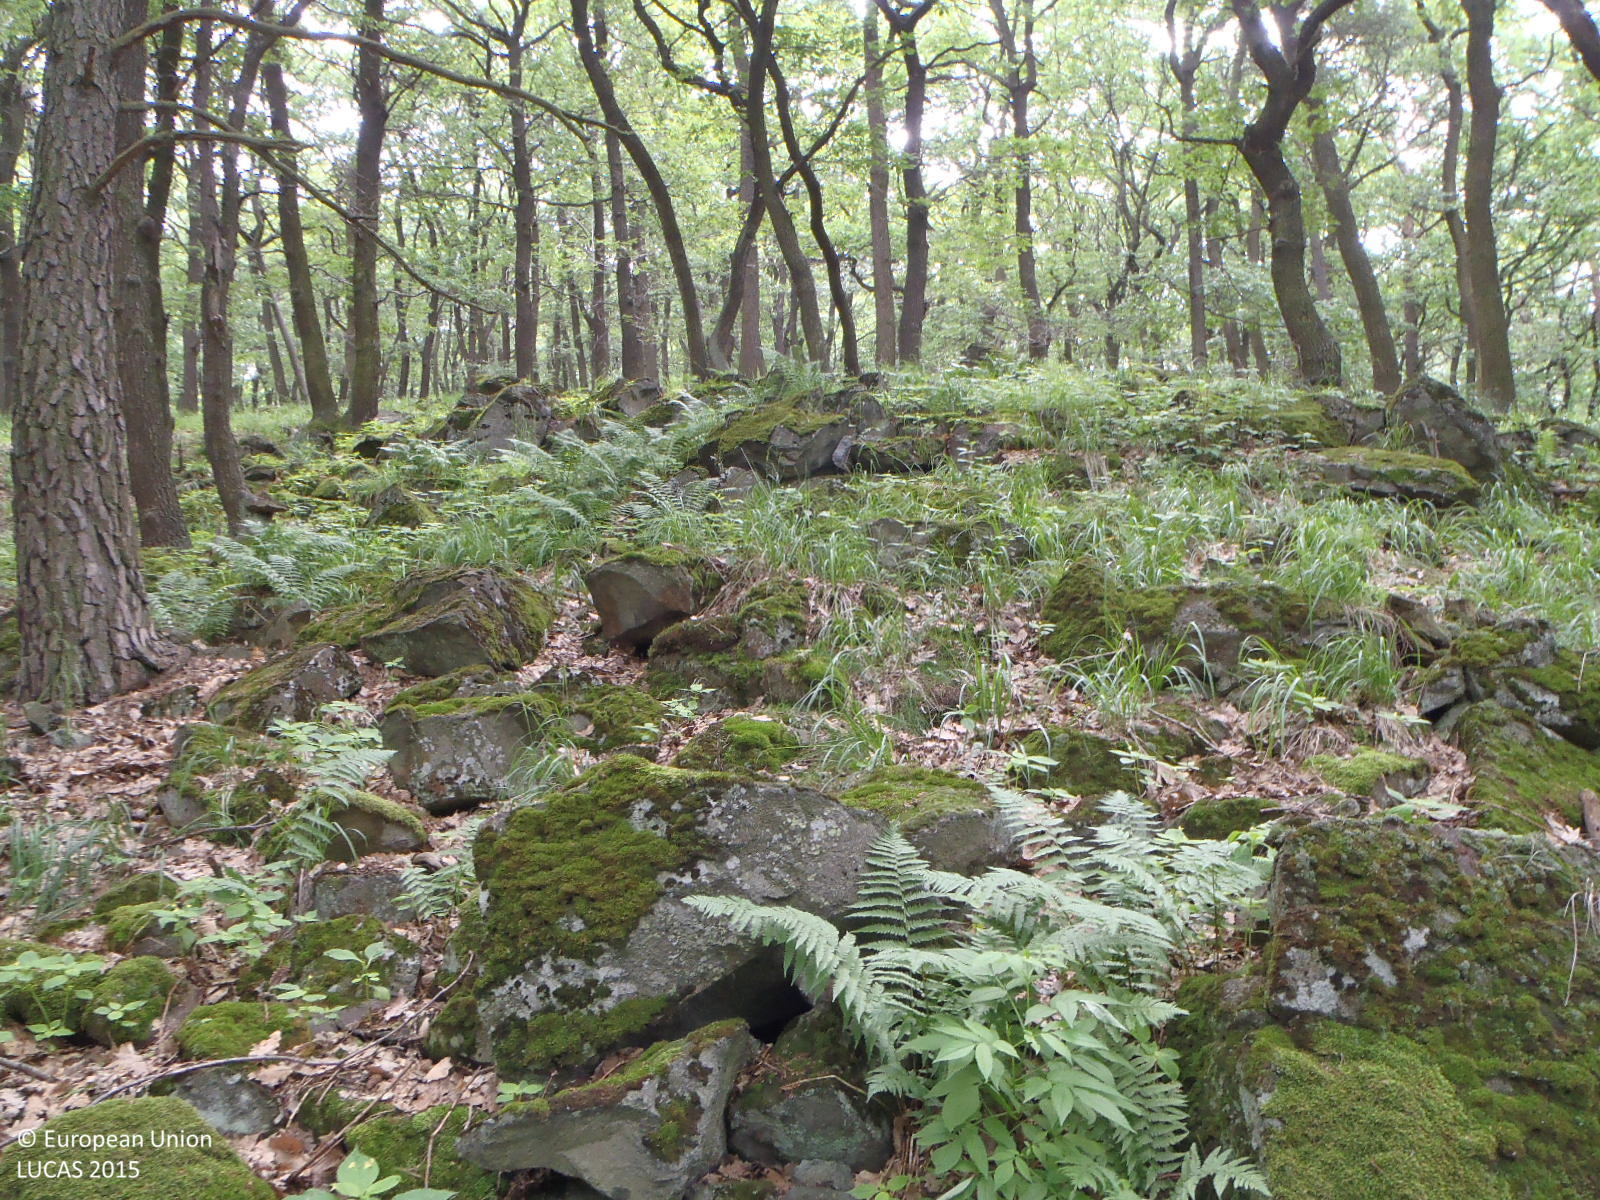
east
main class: Woodland
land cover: Broadleaved woodland
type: acidophilous oak and oak-birch forest
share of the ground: > 75 %
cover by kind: broadleaved forest trees 85 %, coniferous forest trees 5 %, herbaceous plants 5 %, lichens and mosses 5 %
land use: Forestry
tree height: > 5 m
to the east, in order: Broadleaved woodland; Tracks; Other mixed woodland
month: June
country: CZ
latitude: 50.5153
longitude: 13.8509
